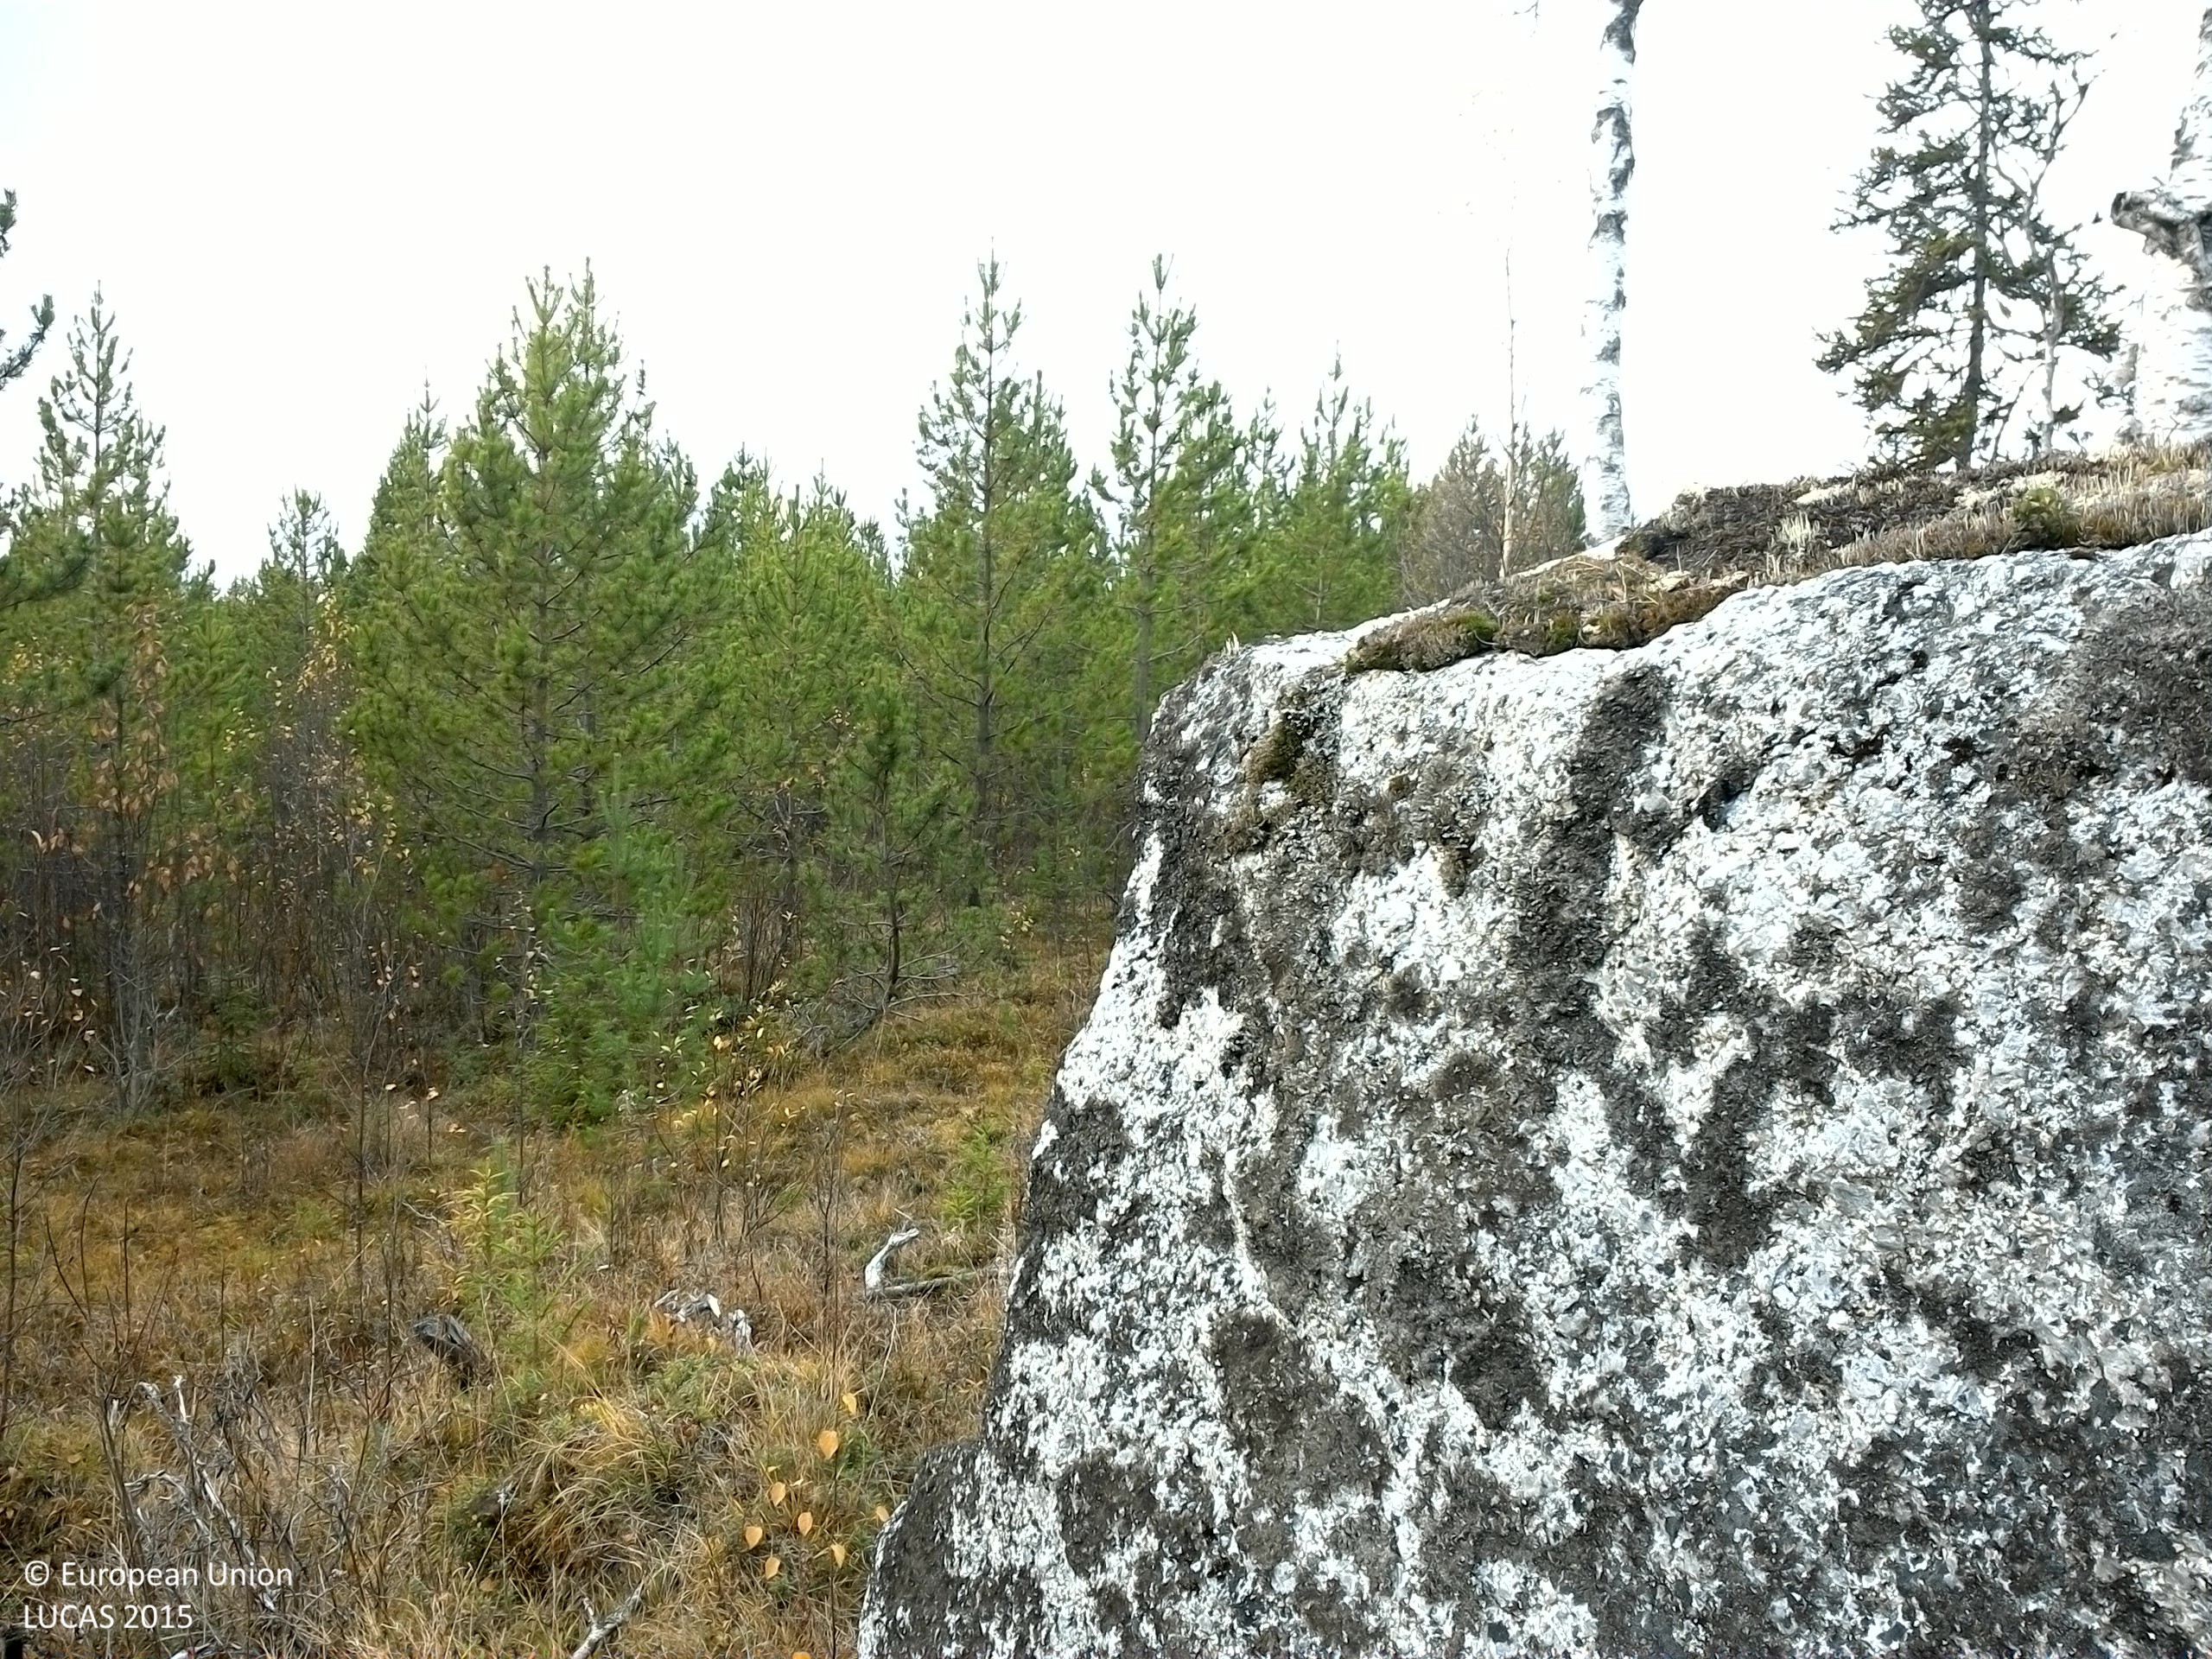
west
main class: Woodland
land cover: Spruce dominated mixed woodland
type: boreal forest
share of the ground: 25 - 50 %
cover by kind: shrubs 40 %, broadleaved forest trees 15 %, lichens and mosses 15 %, coniferous forest trees 10 %, herbaceous plants 10 %, consolidated bare surface 10 %
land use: Forestry
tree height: < 5 m
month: October
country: SE
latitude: 64.0159
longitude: 15.9248
